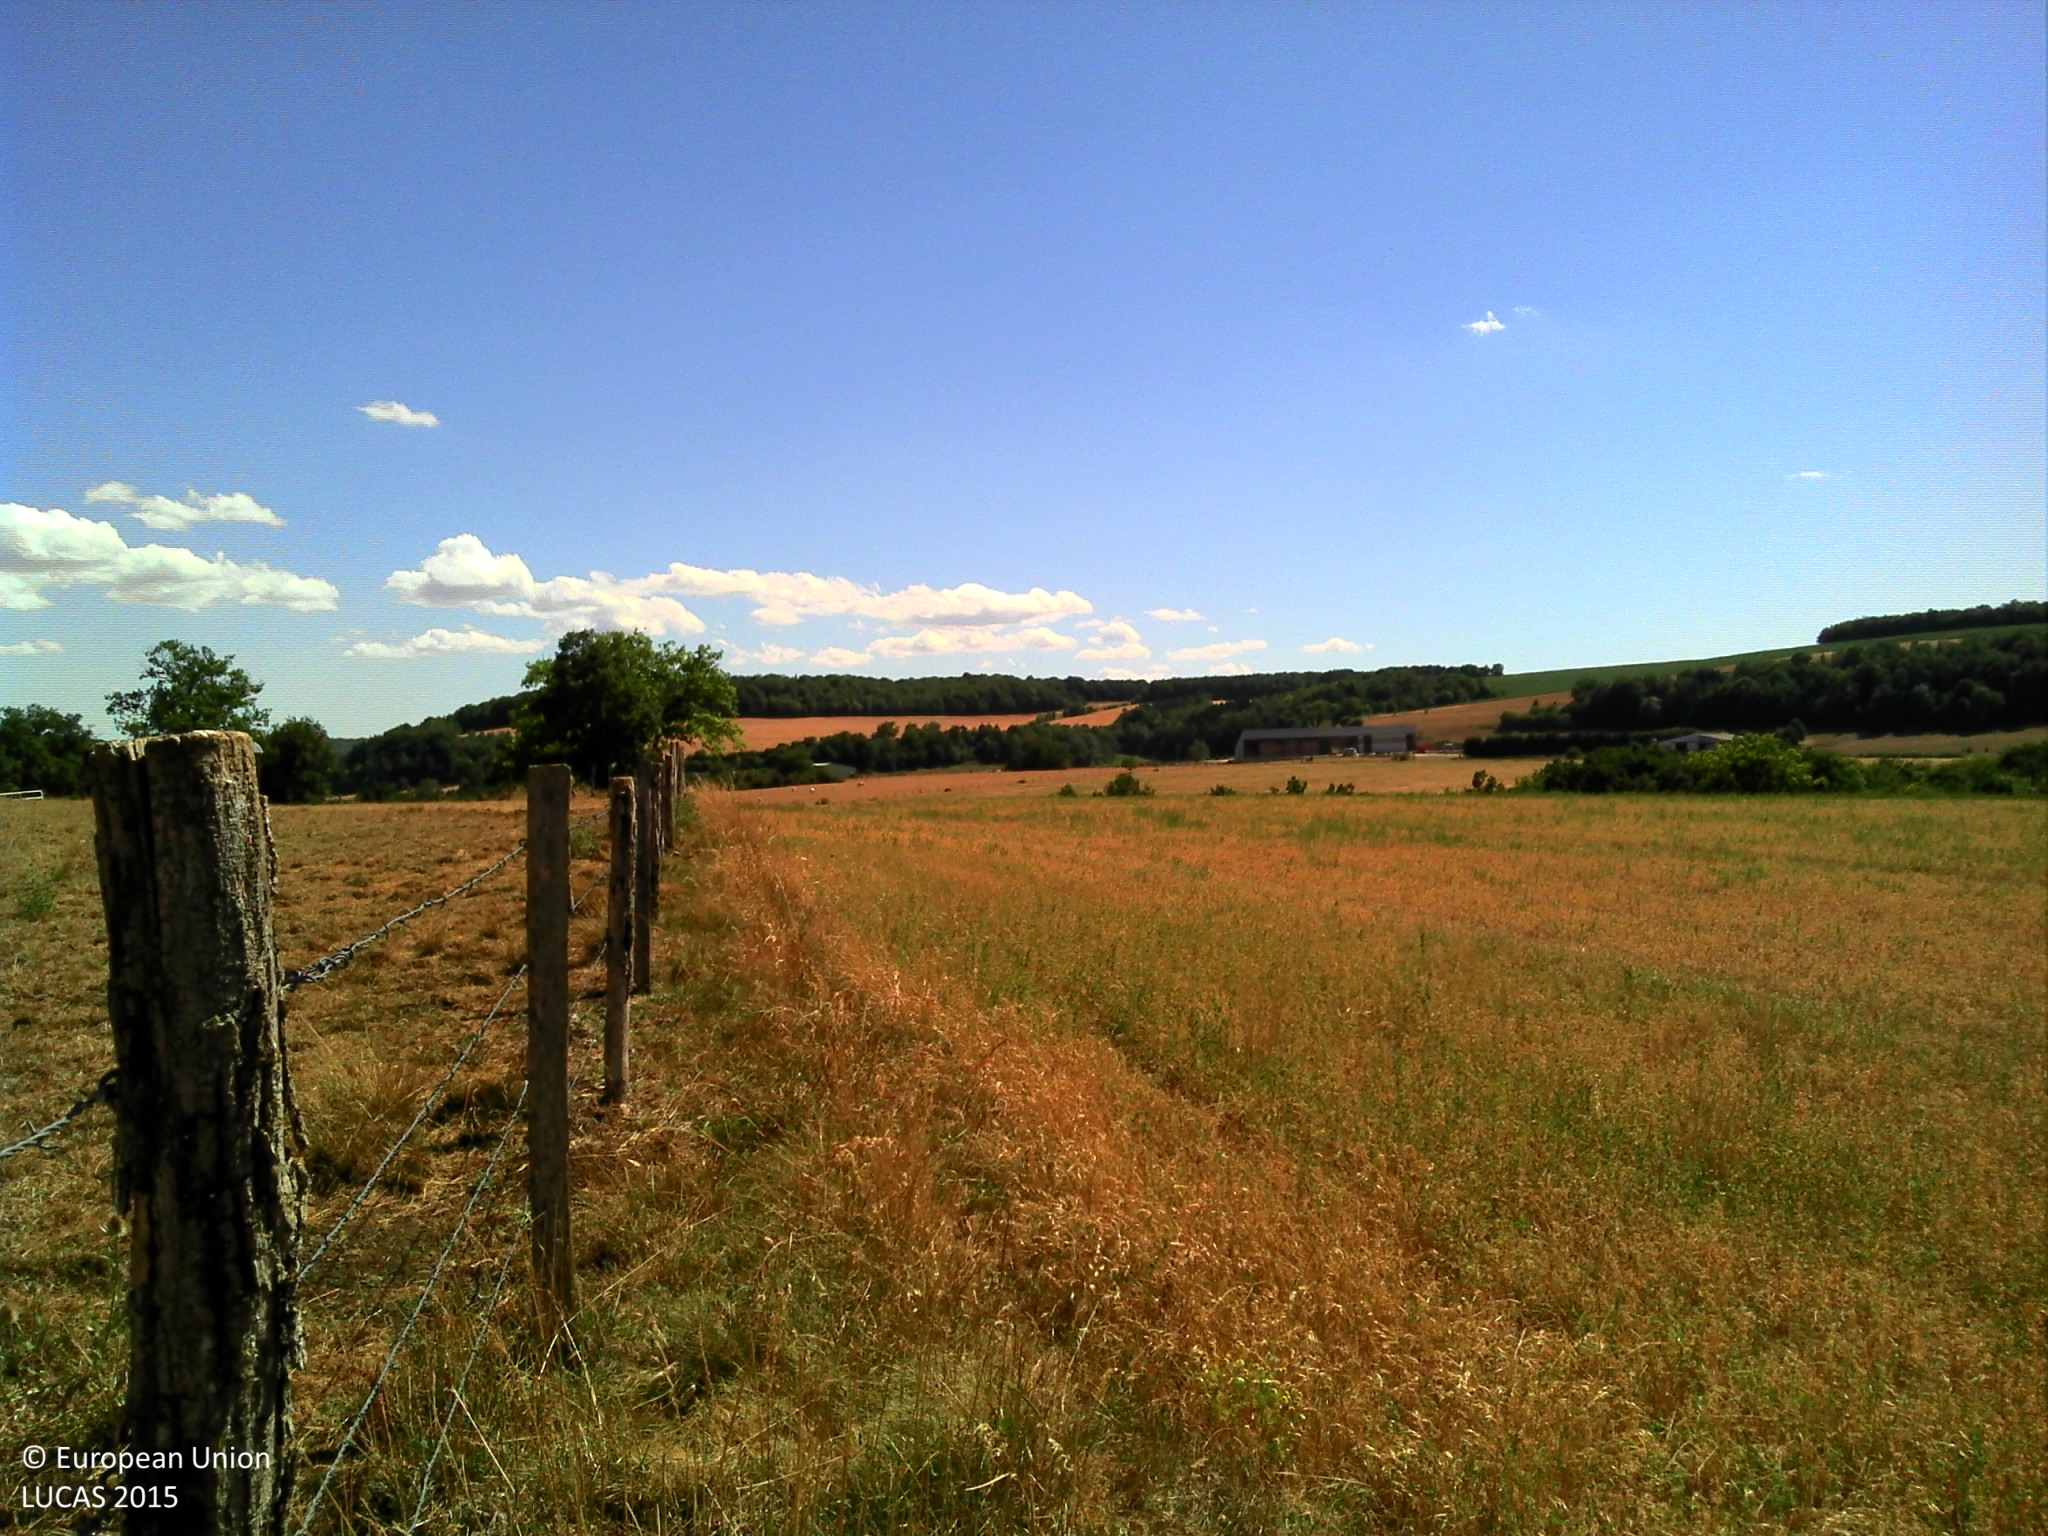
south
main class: Grassland
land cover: Grassland without tree/shrub cover
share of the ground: > 75 %
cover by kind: herbaceous plants 100 %
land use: Agriculture (excluding fallow land and kitchen gardens)
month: July
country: FR
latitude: 47.8452
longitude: 5.1222
